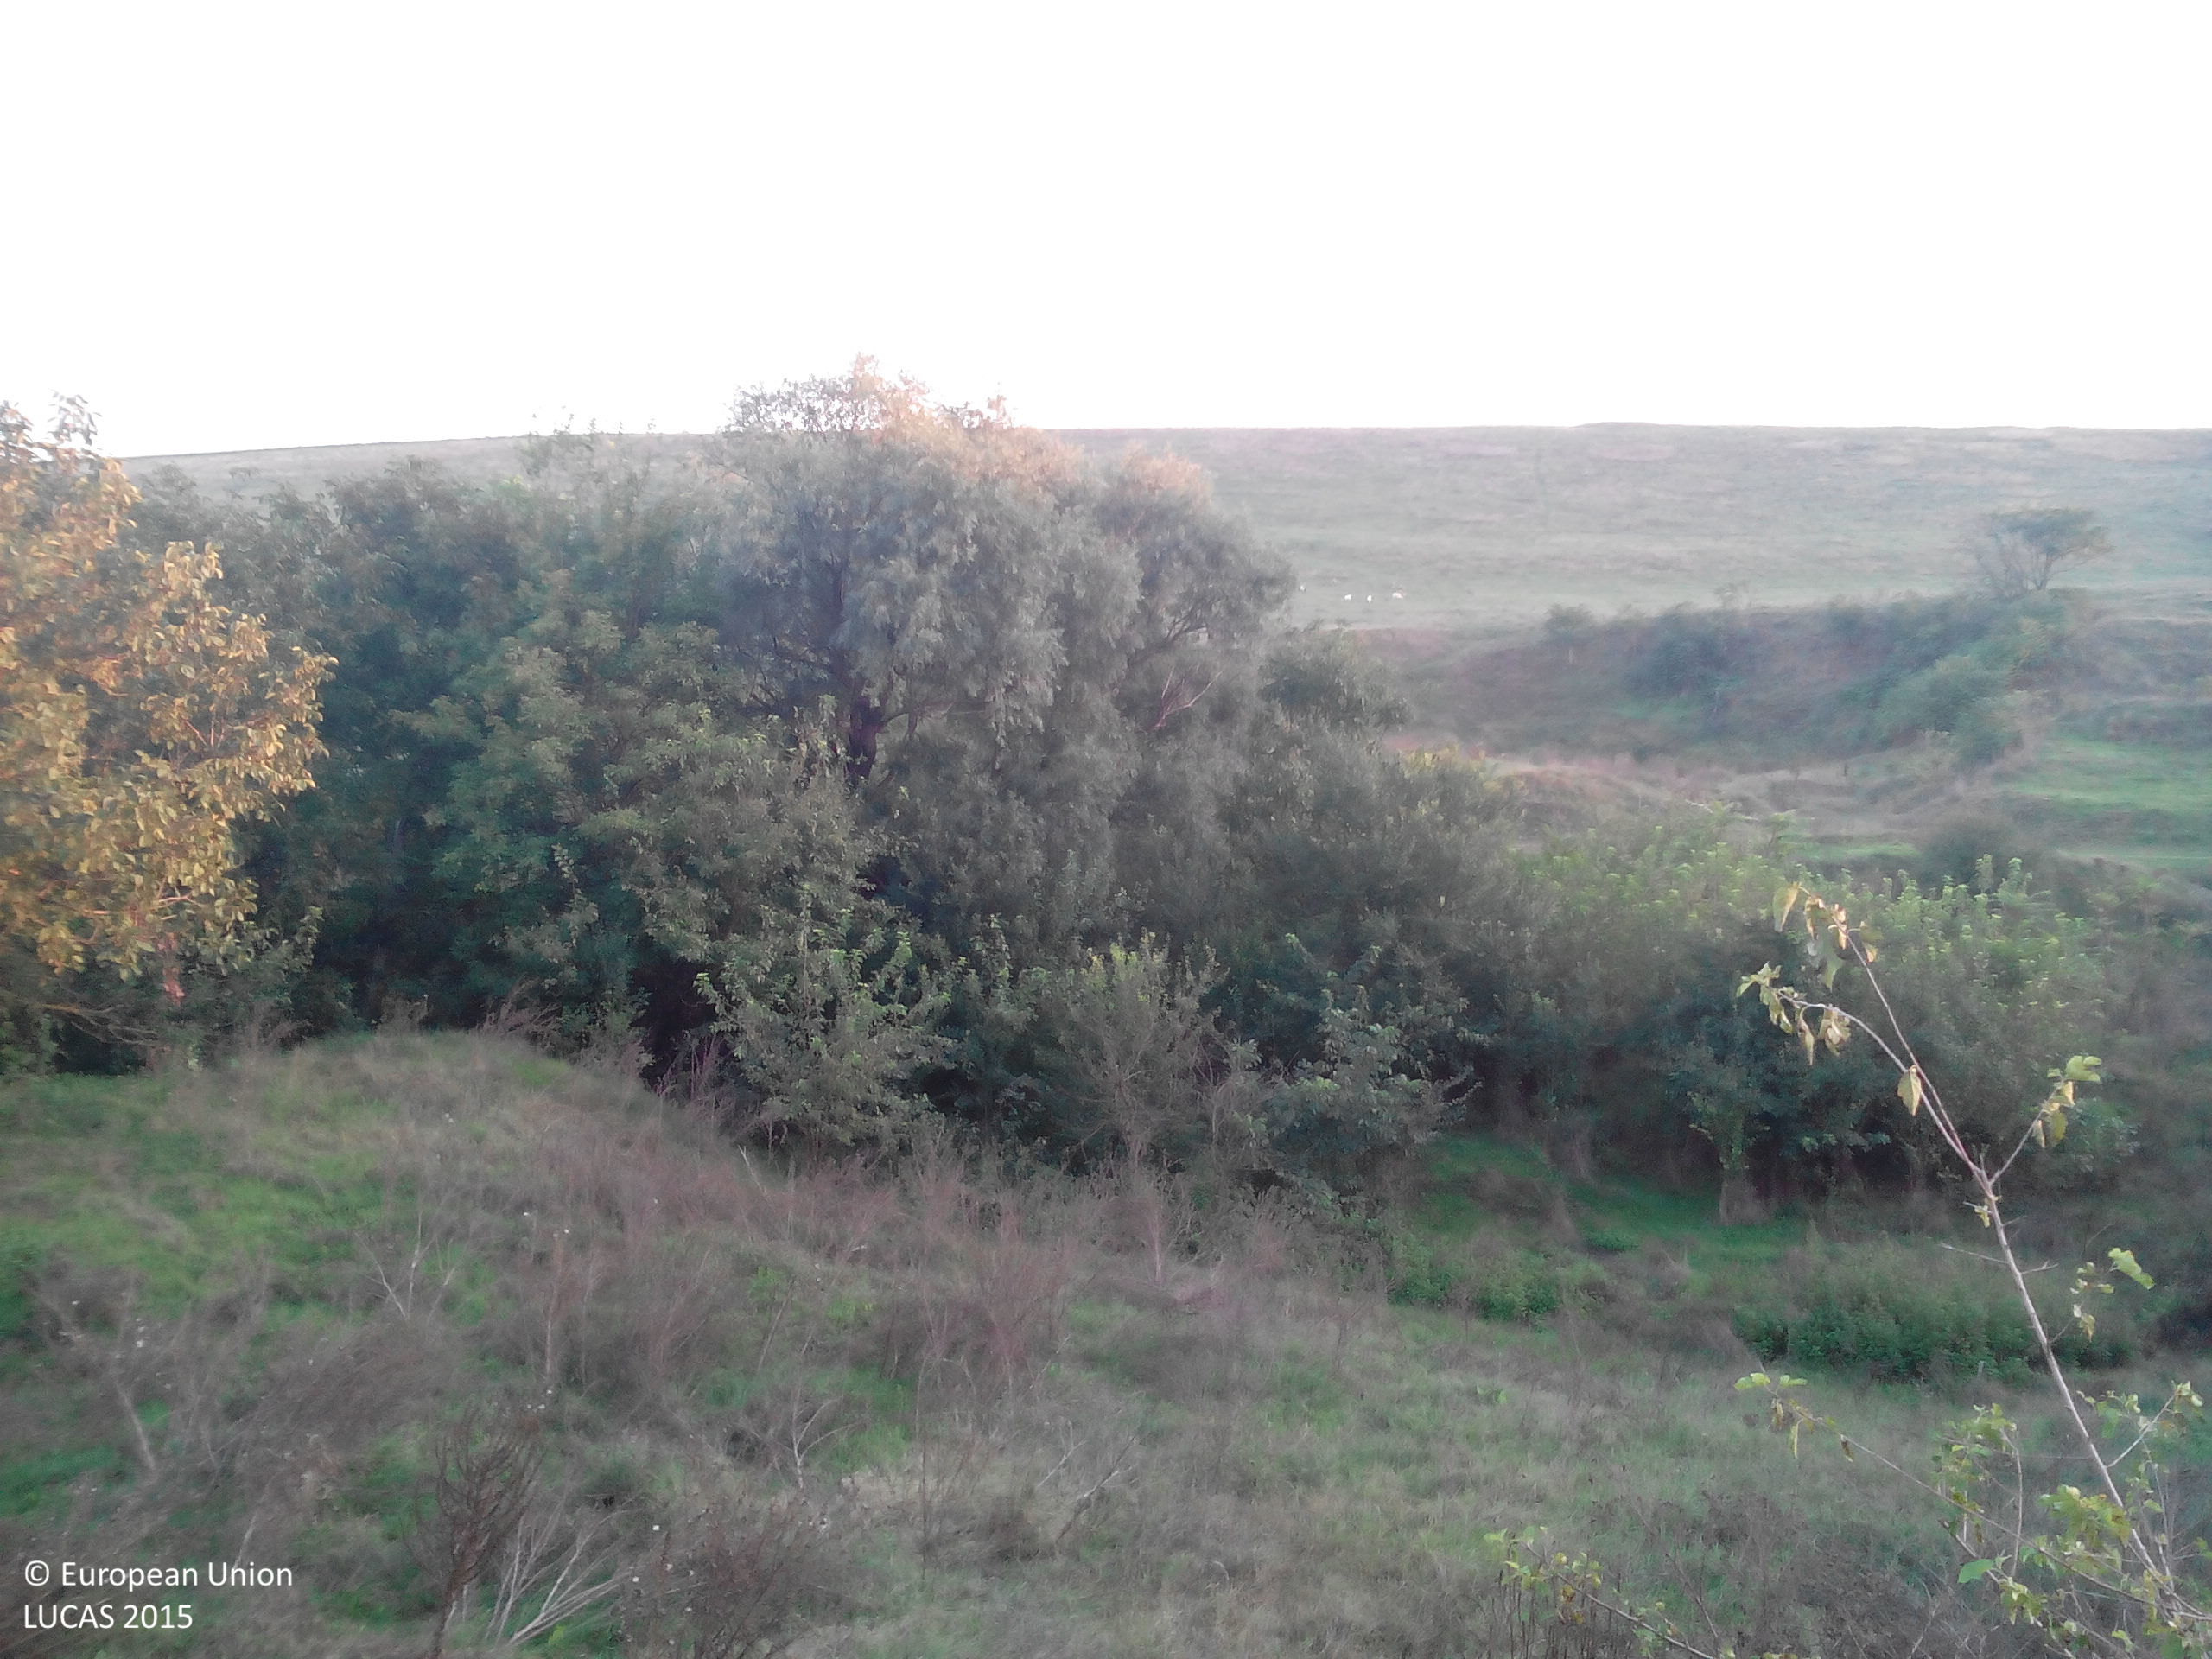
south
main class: Woodland
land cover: Broadleaved woodland
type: mesophytic deciduous forest
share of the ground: 25 - 50 %
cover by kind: herbaceous plants 60 %, broadleaved forest trees 30 %, shrubs 10 %
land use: Semi-natural and natural areas not in use
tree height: > 5 m
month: October
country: BG
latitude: 43.5589
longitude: 23.8792
